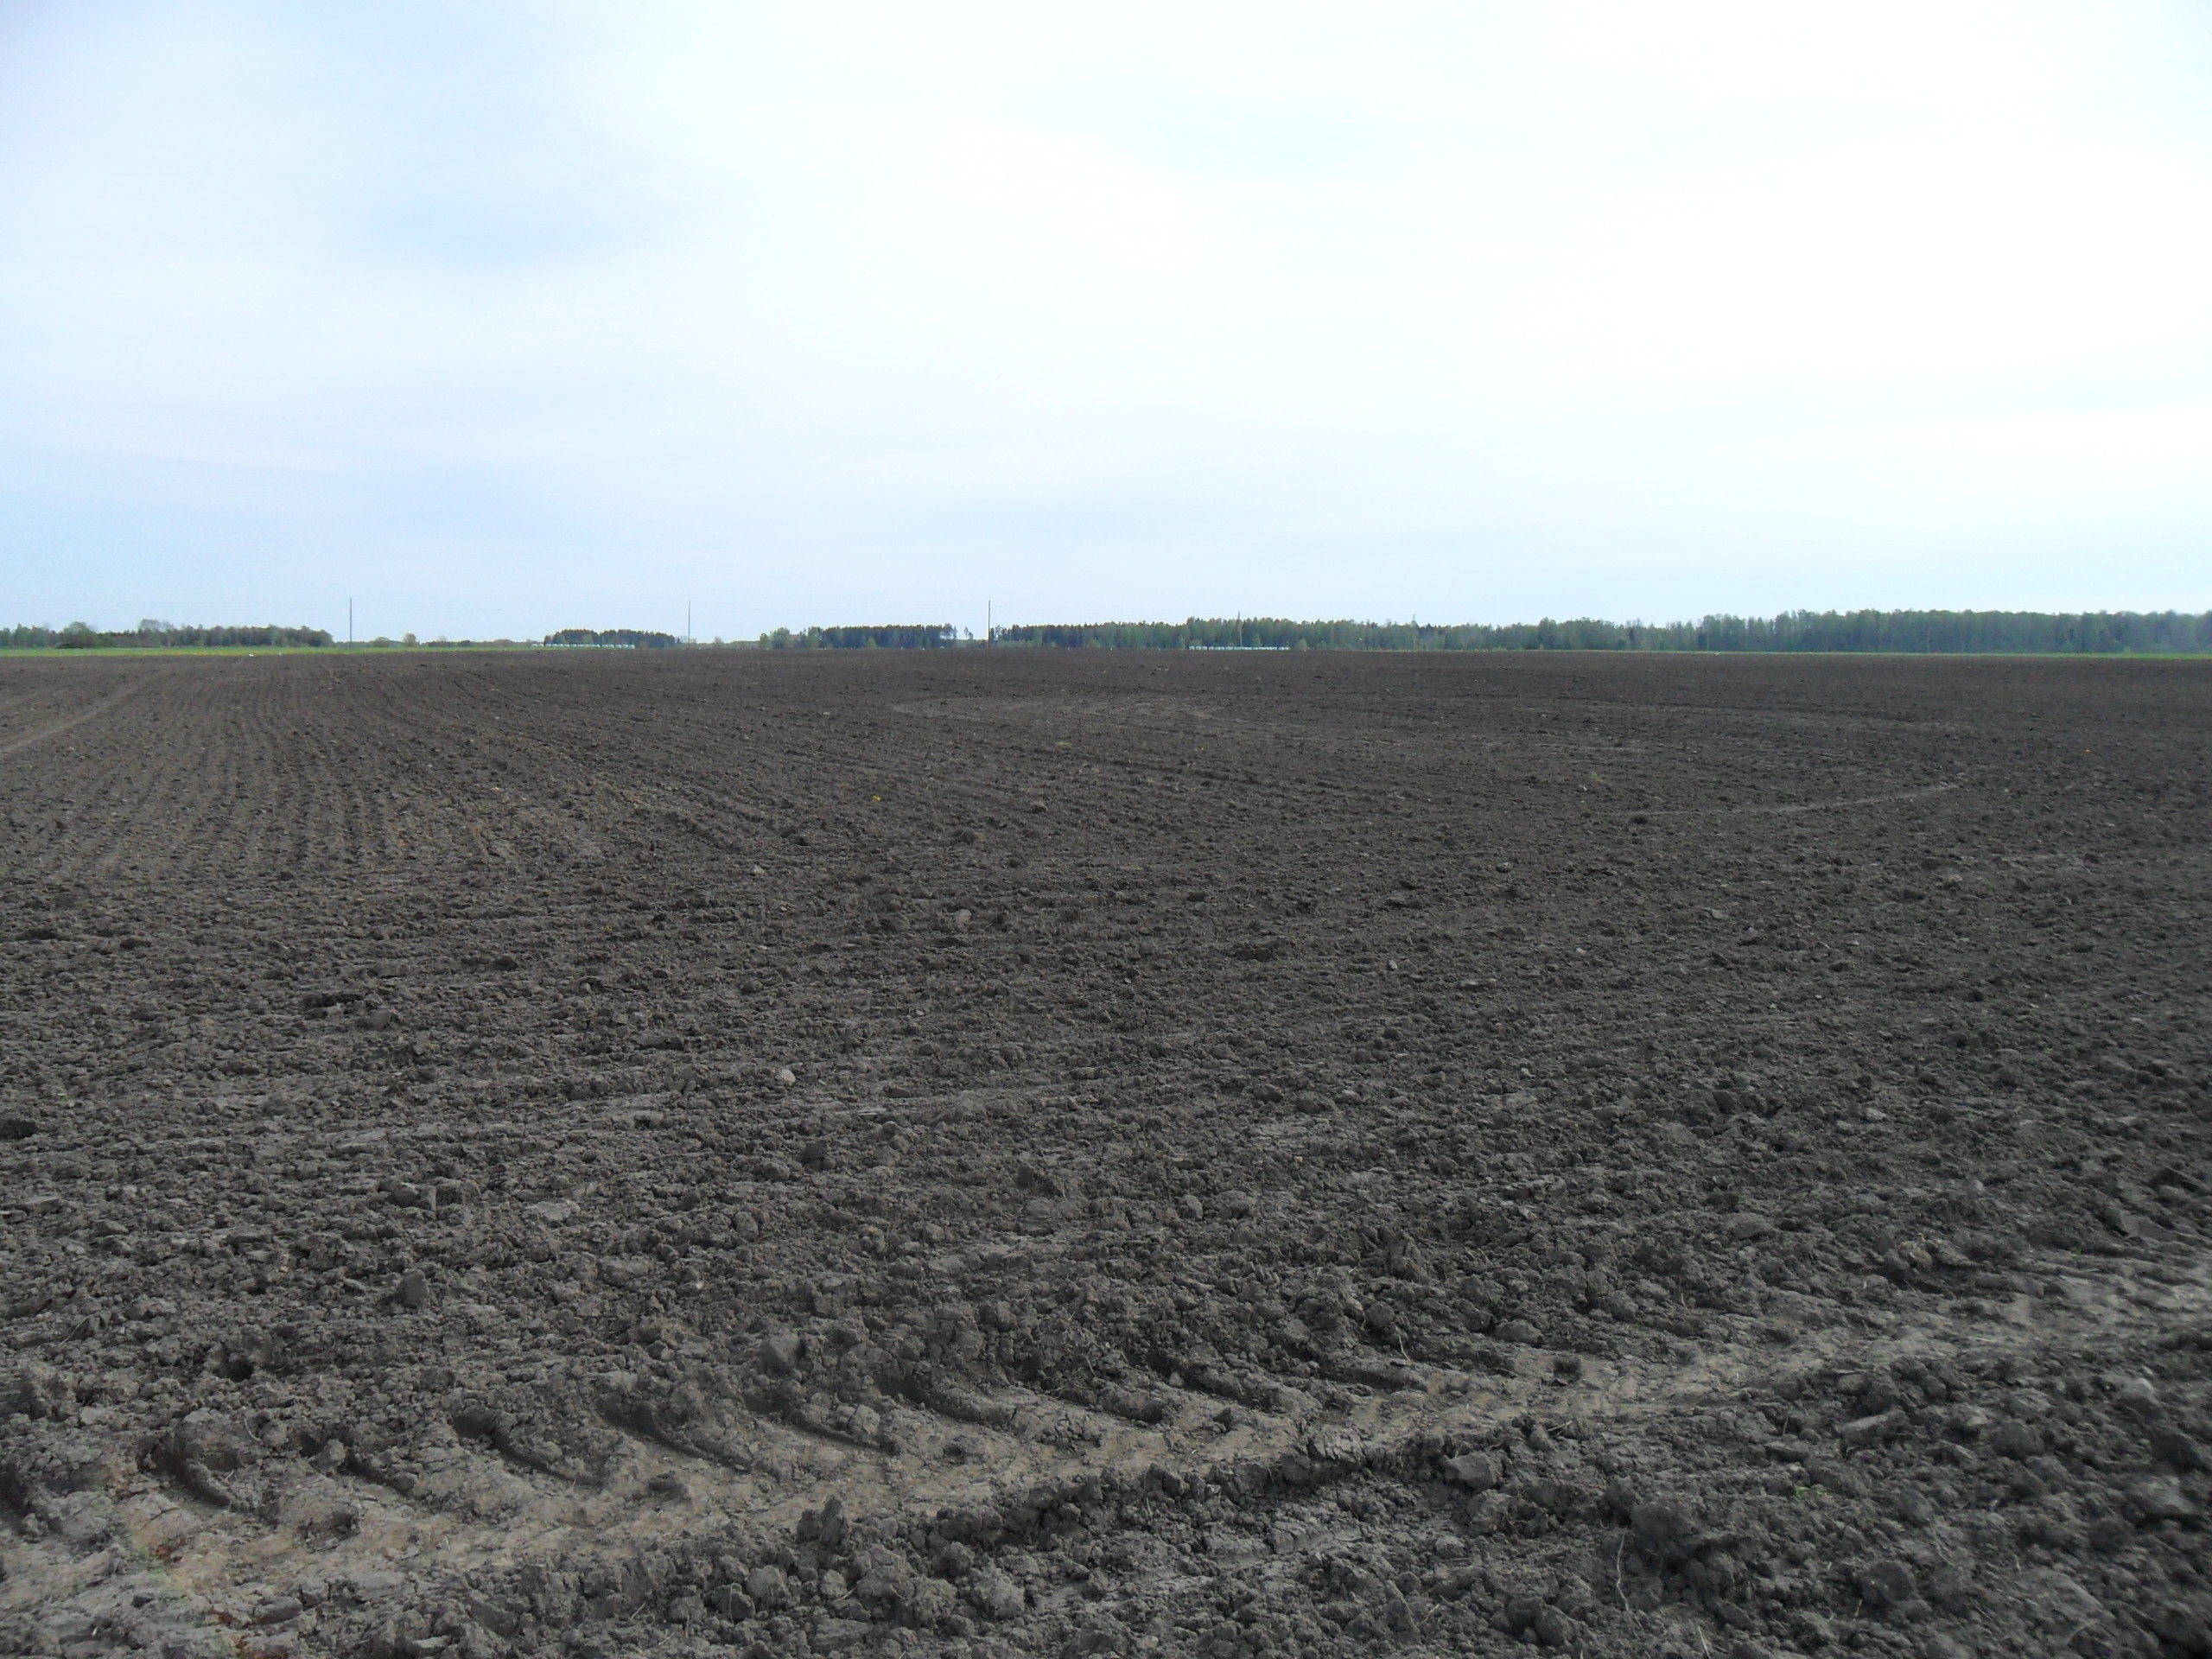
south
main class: Cropland
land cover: Rape and turnip rape
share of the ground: < 10 %
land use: Agriculture (excluding fallow land and kitchen gardens)
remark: Tilled/Sowed
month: May
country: LV
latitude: 57.2728
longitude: 23.0149
